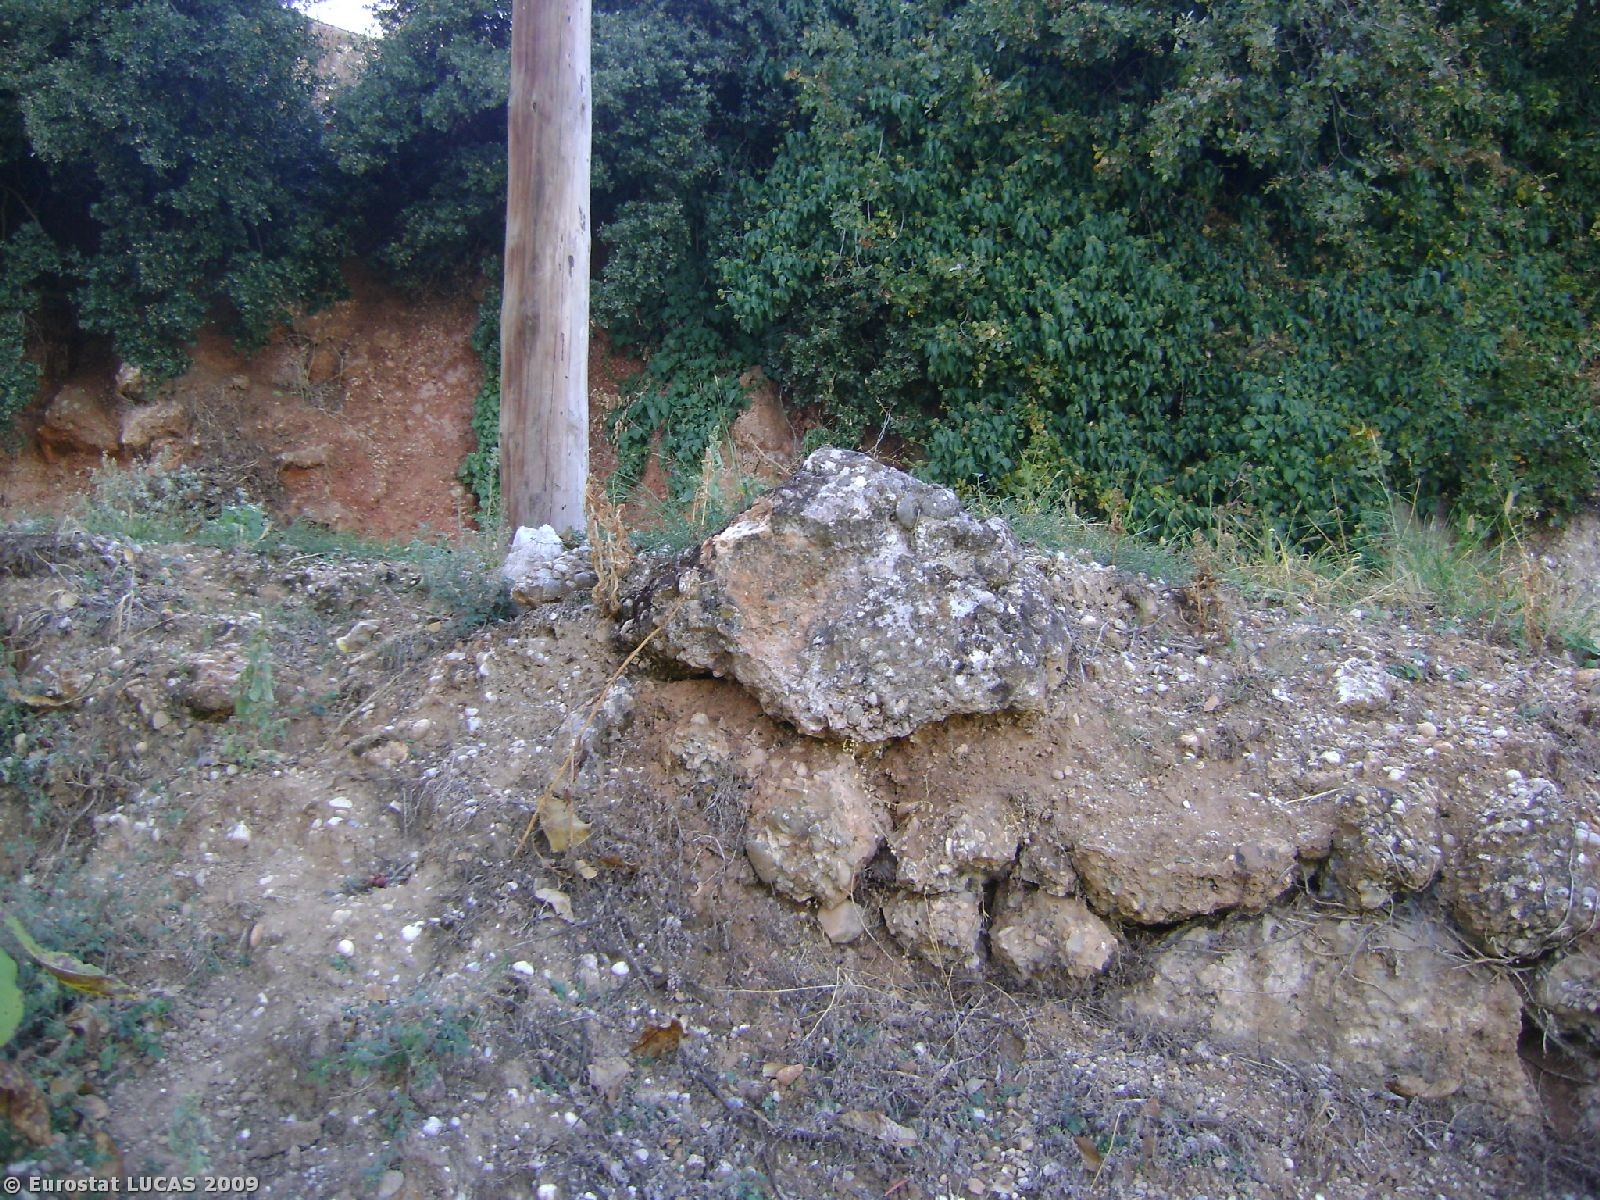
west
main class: Grassland
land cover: Grassland without tree/shrub cover
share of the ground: > 75 %
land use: Unused
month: October
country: GR
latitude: 38.0973
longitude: 22.3190
